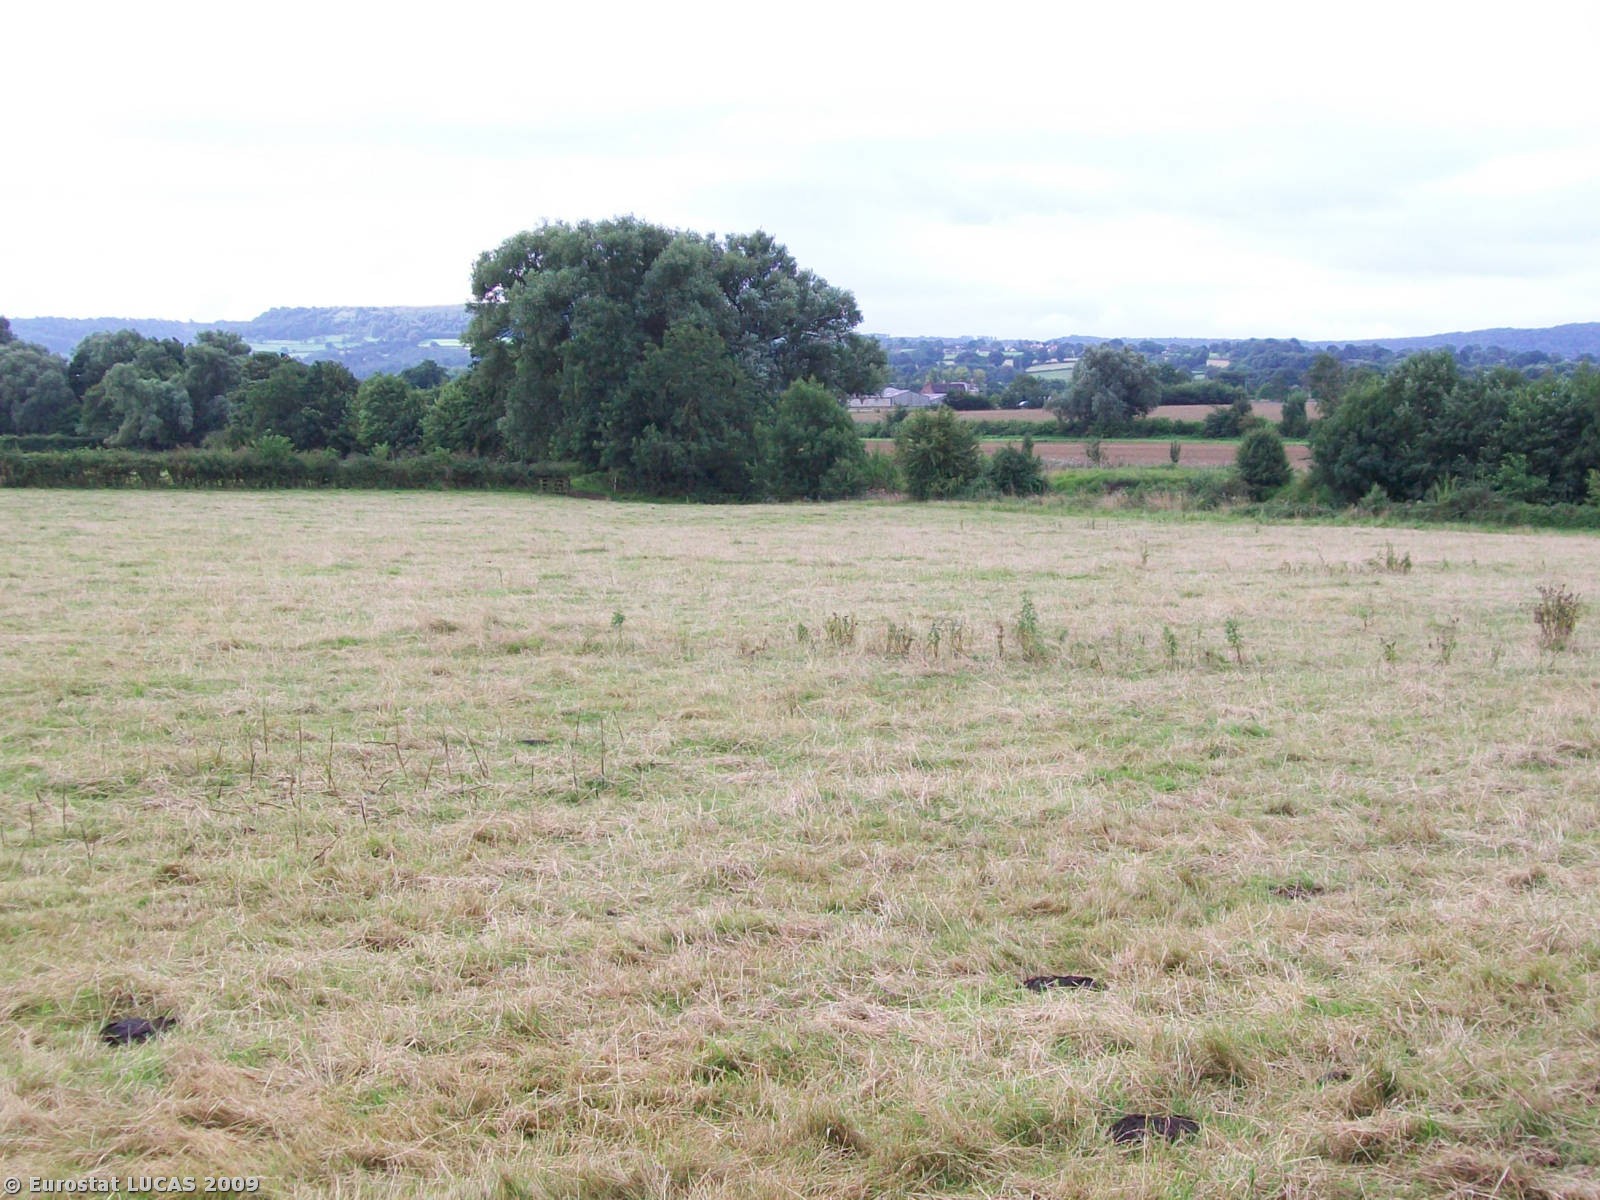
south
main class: Cropland
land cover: Temporary grasslands
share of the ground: > 75 %
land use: Agriculture (excluding fallow land and kitchen gardens)
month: August
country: GB
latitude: 51.7289
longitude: -2.3562
